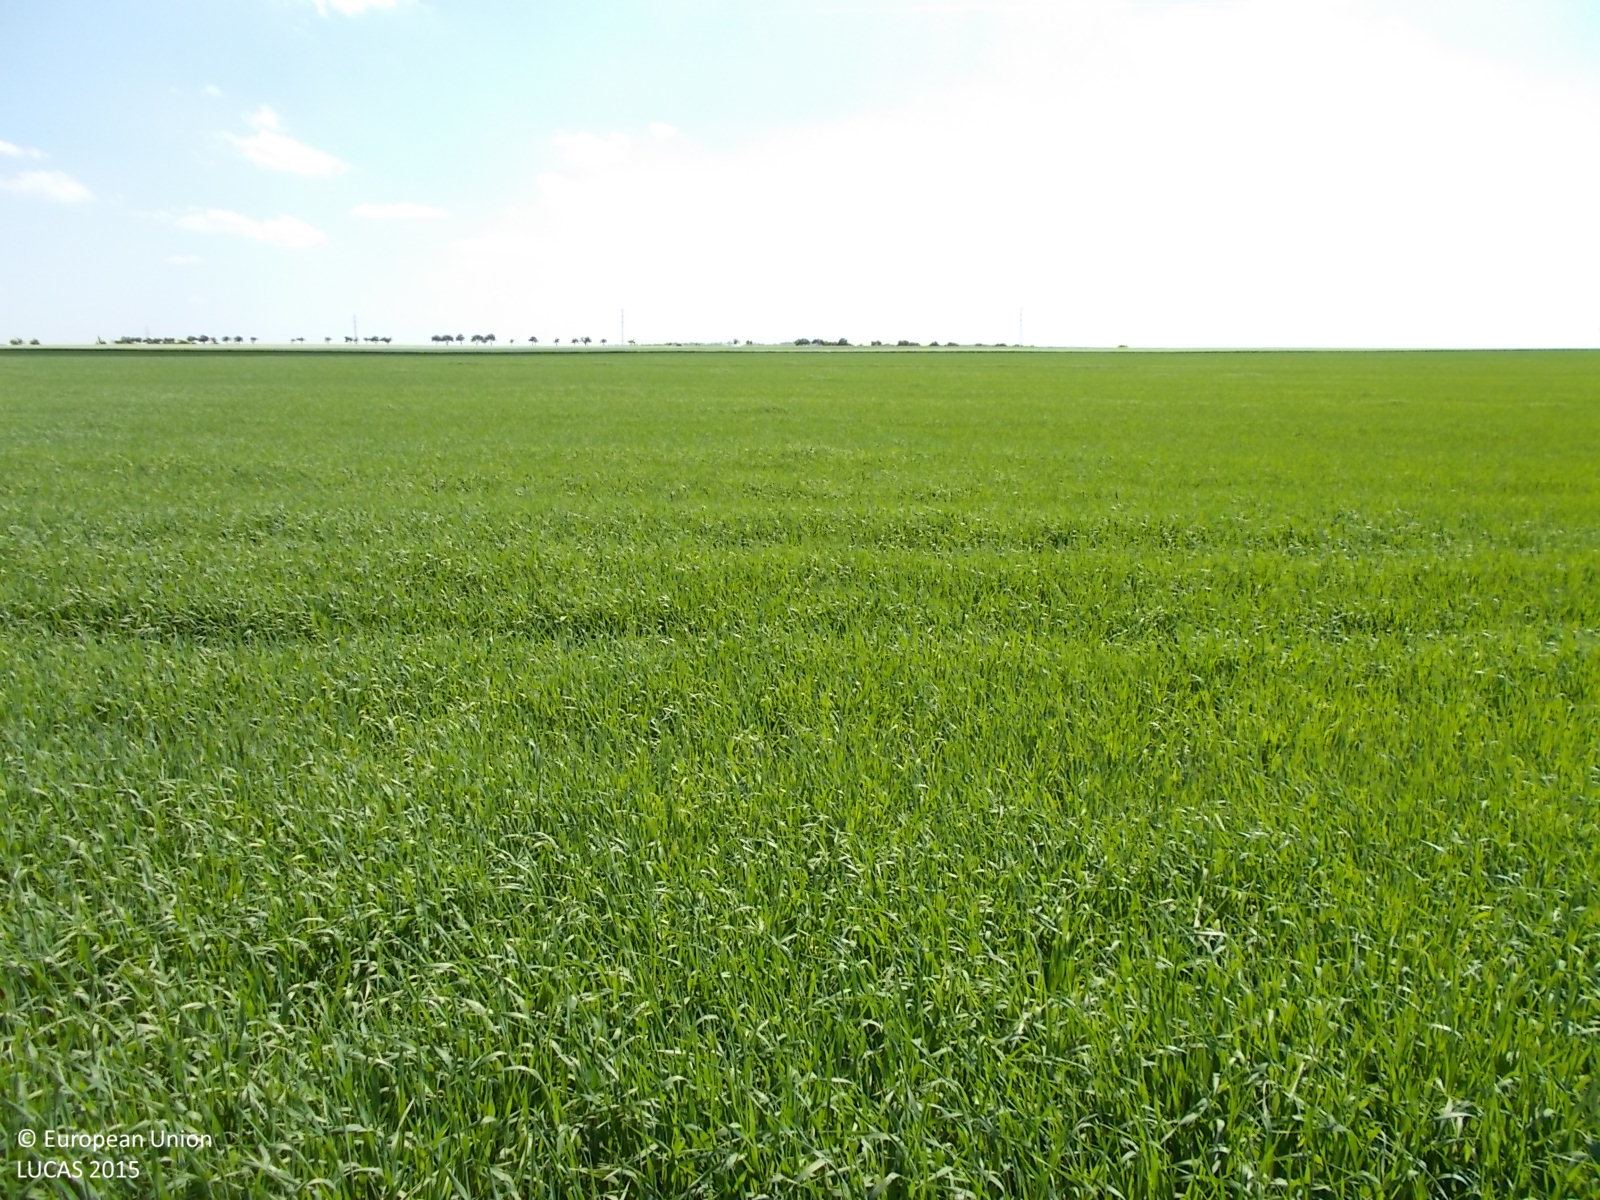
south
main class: Cropland
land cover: Barley
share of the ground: > 75 %
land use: Agriculture (excluding fallow land and kitchen gardens)
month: June
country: CZ
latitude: 49.9061
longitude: 15.1409
